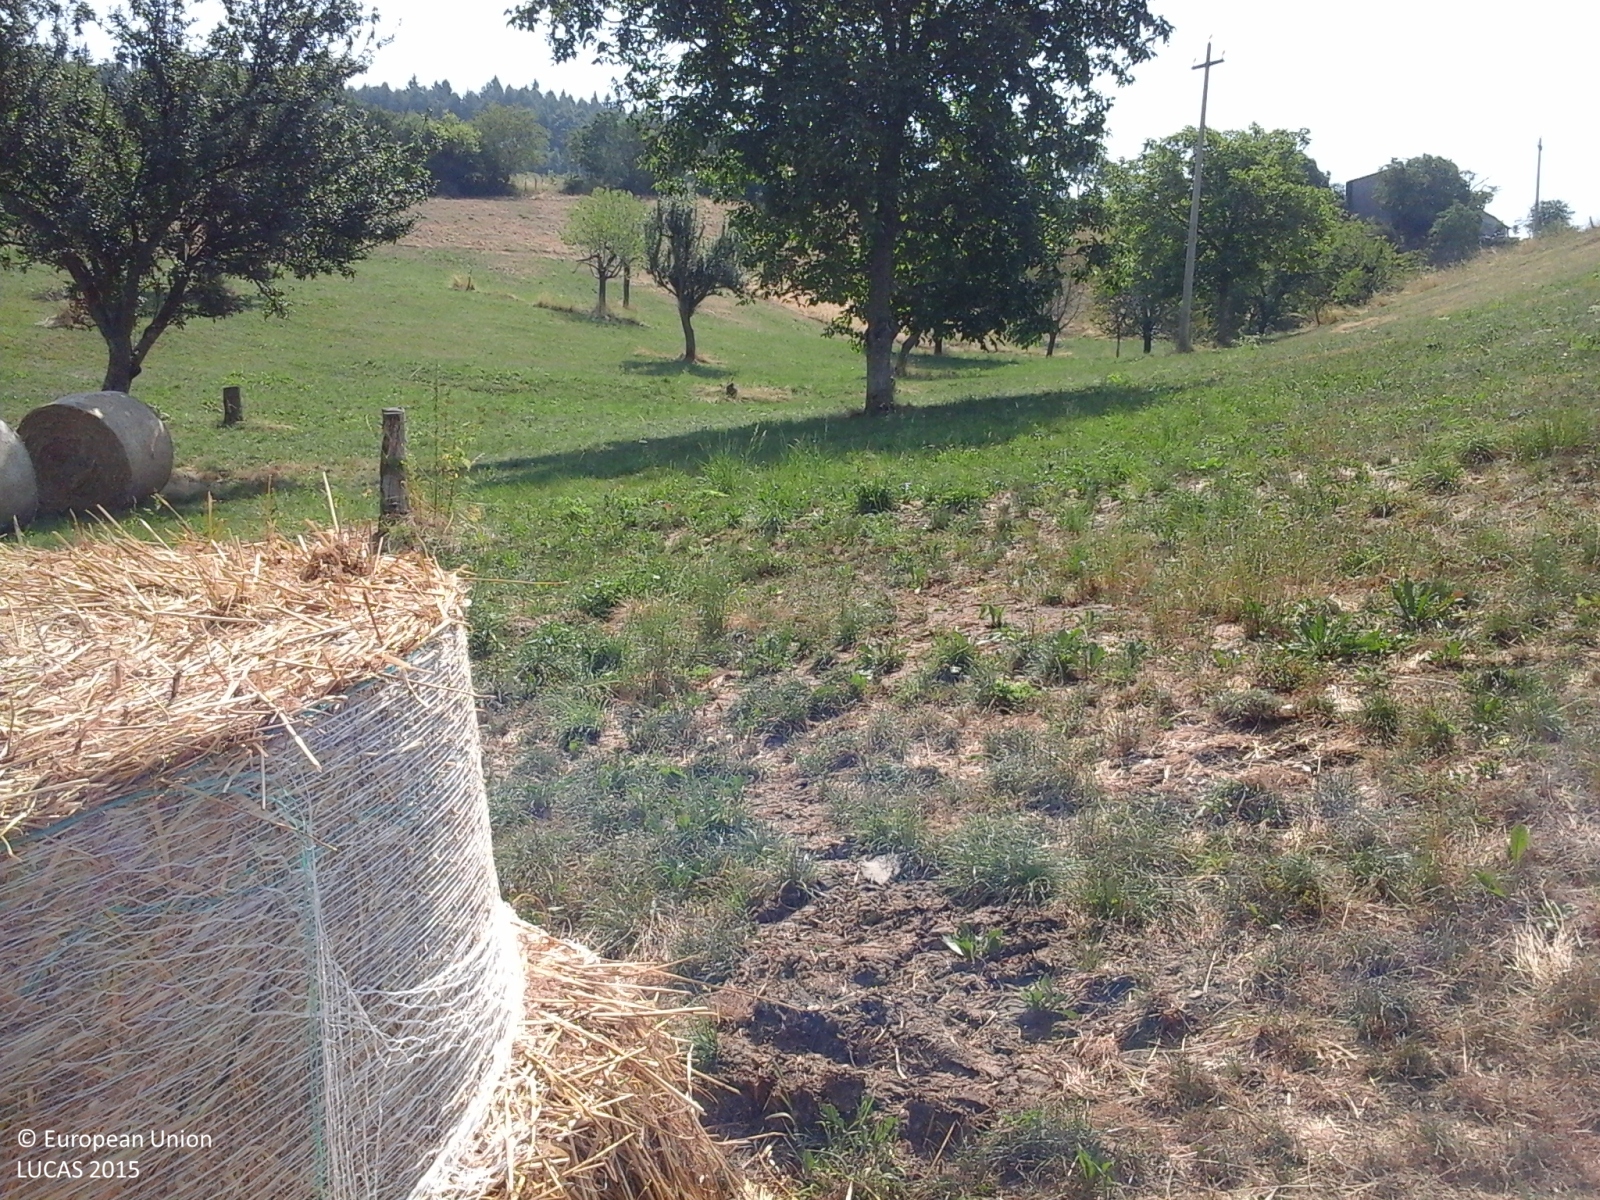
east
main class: Grassland
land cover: Grassland without tree/shrub cover
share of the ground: > 75 %
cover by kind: herbaceous plants 100 %
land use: Agriculture (excluding fallow land and kitchen gardens)
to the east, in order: Grassland without tree/shrub cover; Grassland with sparse tree/shrub cover; Electric lines; Grassland with sparse tree/shrub cover; Grassland without tree/shrub cover; Broadleaved woodland; Tracks; Grassland without tree/shrub cover; Broadleaved woodland
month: July
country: IT
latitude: 45.5706
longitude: 11.1129
